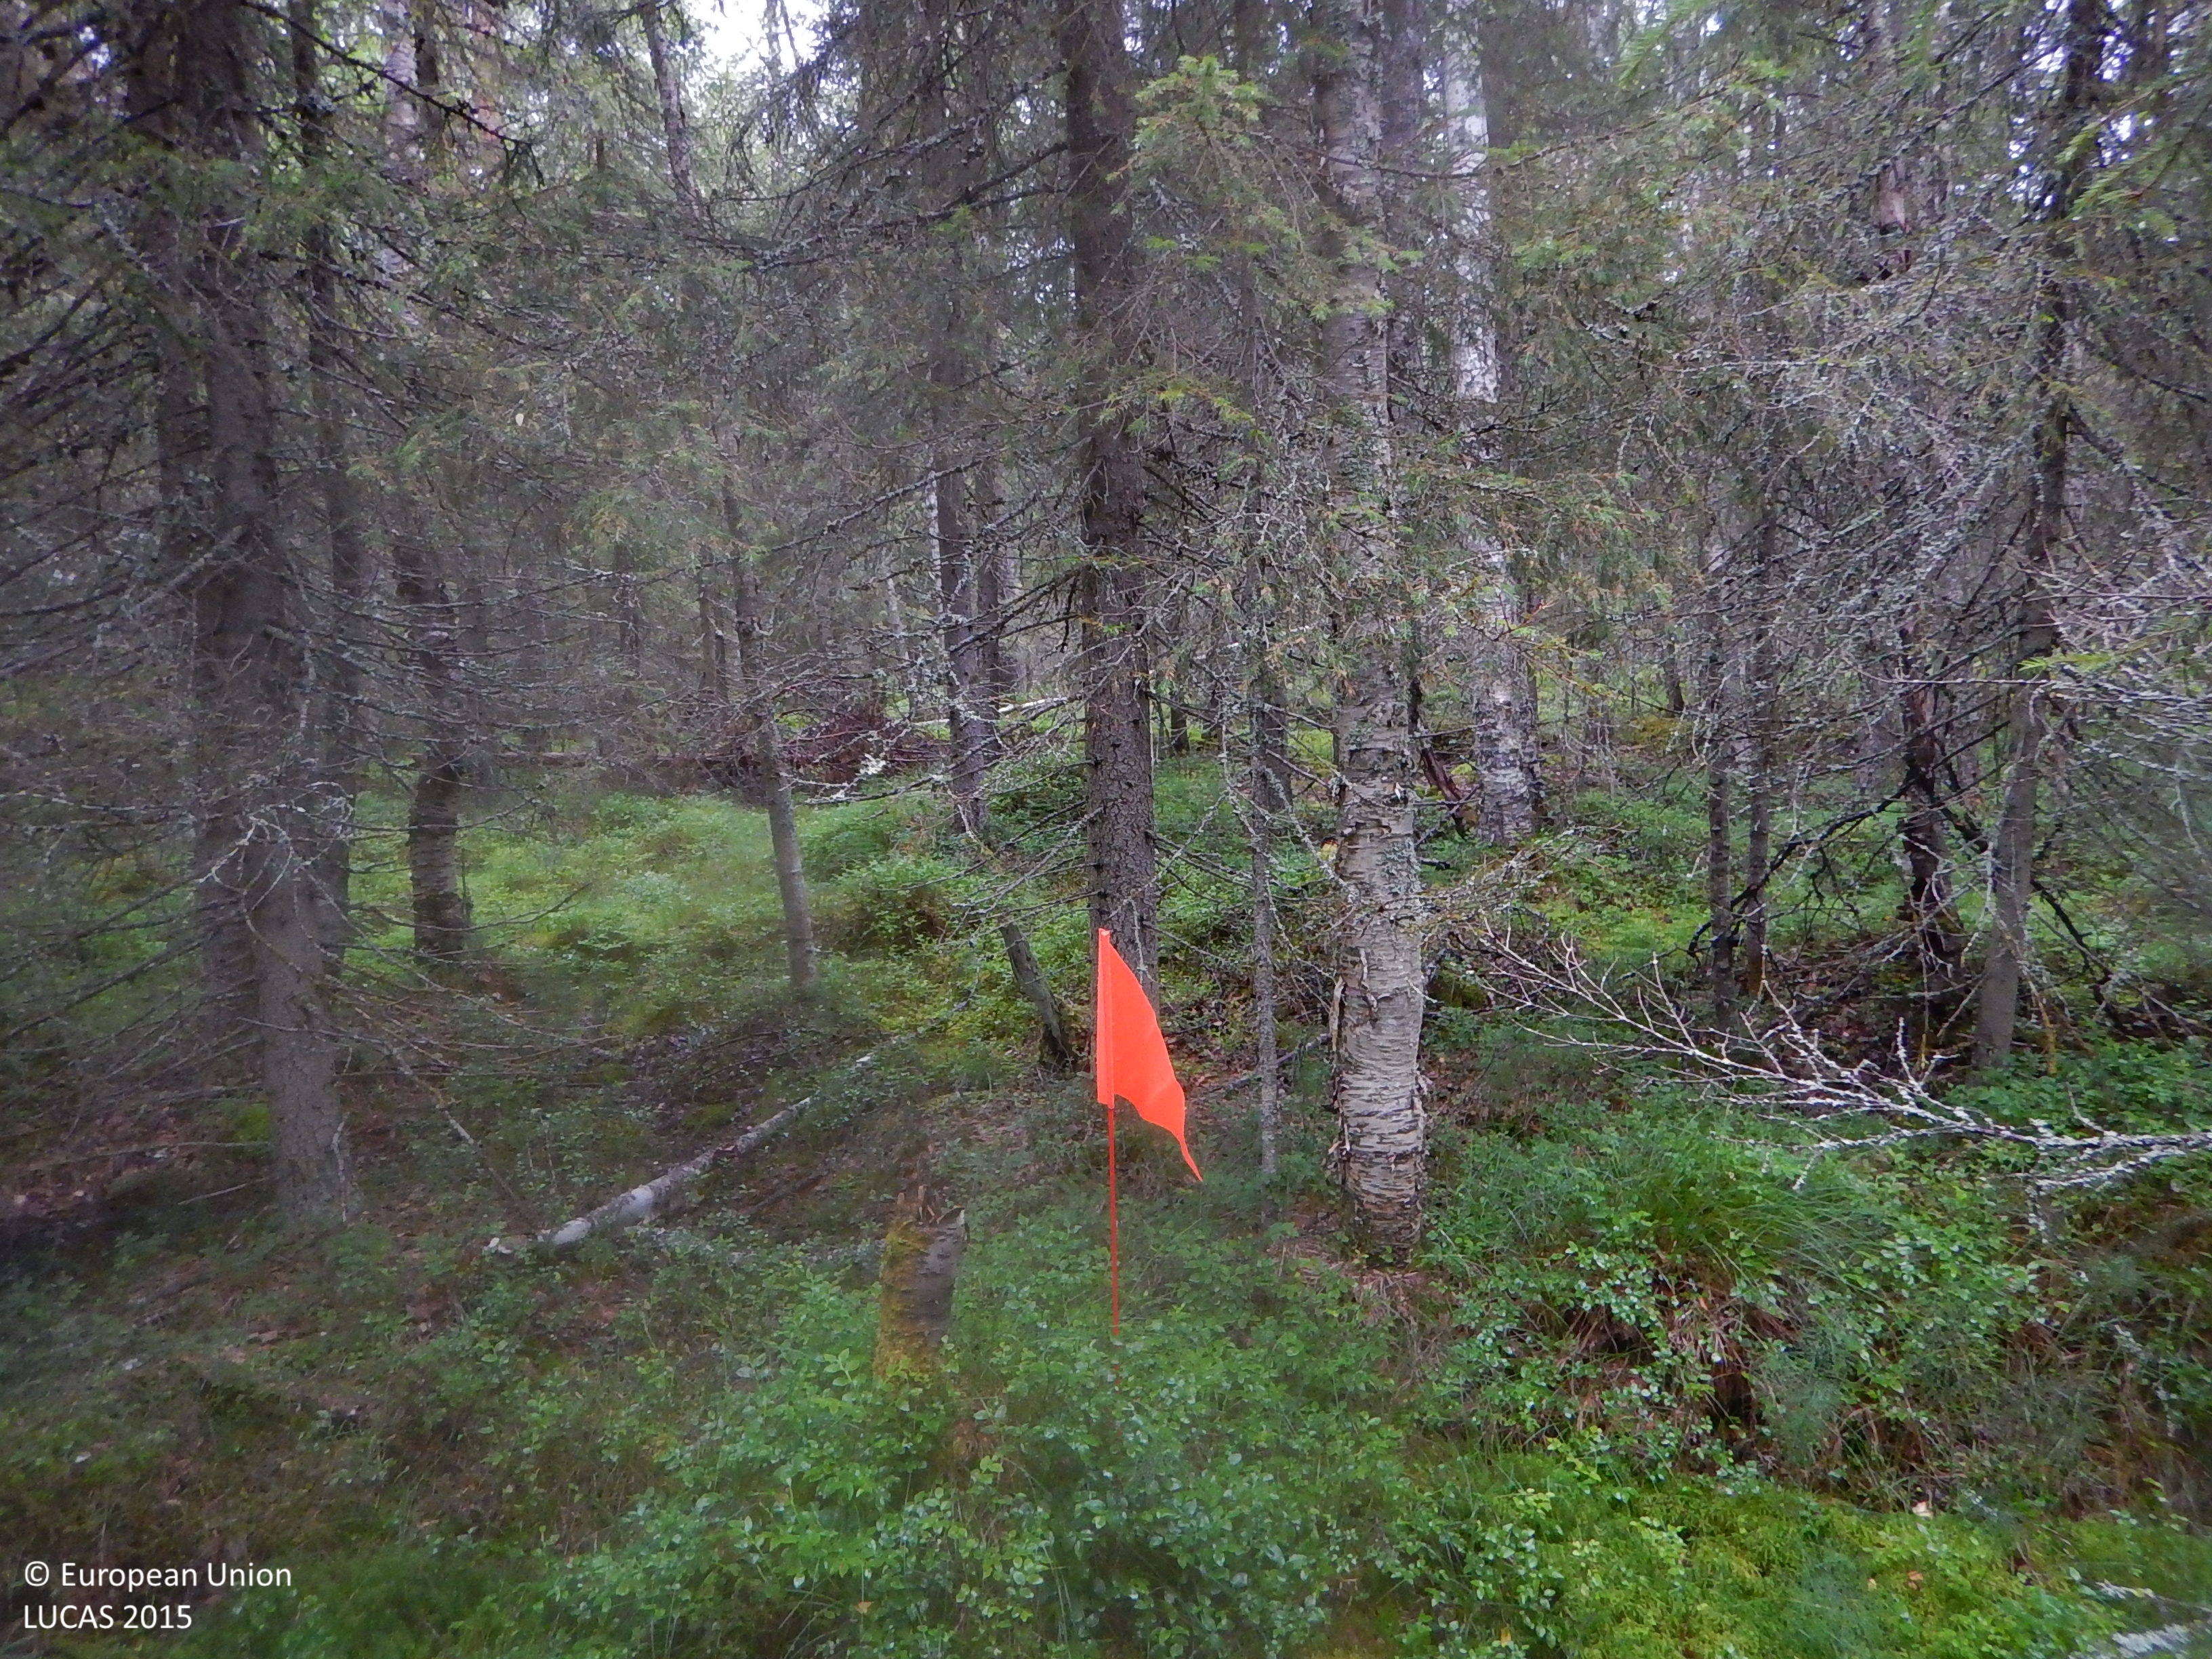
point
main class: Woodland
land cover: Spruce dominated mixed woodland
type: mire and swamp forests
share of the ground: 50 - 75 %
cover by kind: coniferous forest trees 45 %, broadleaved forest trees 15 %, shrubs 15 %, lichens and mosses 15 %, herbaceous plants 10 %
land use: Forestry
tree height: > 5 m
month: July
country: SE
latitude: 65.0182
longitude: 20.4763
